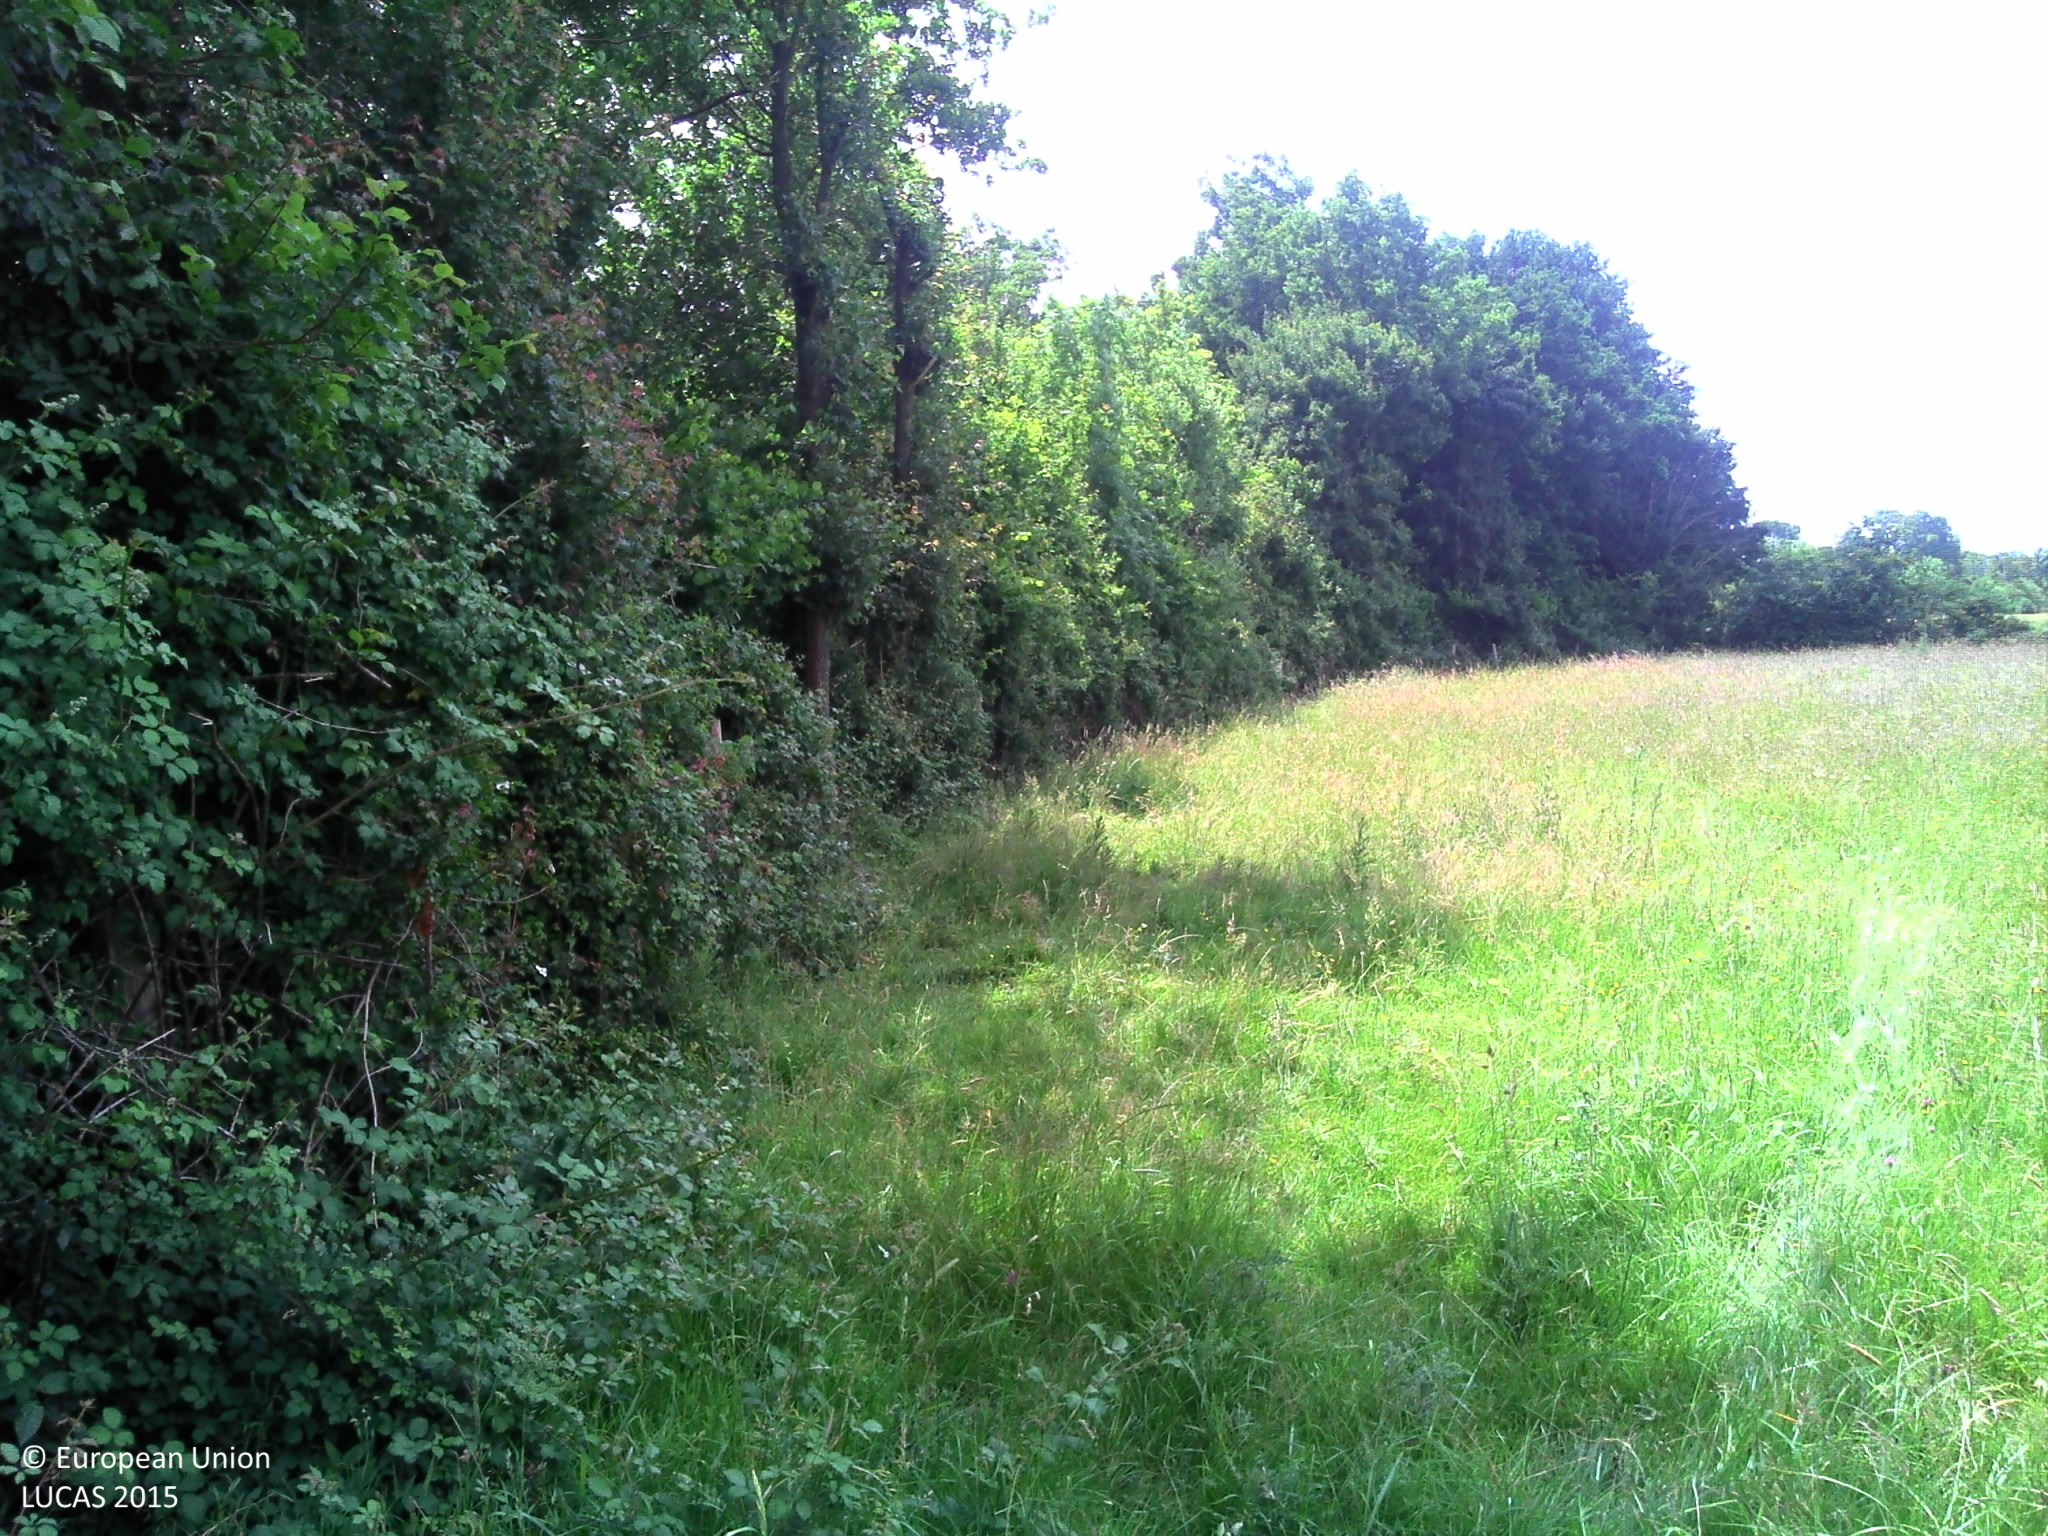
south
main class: Grassland
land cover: Grassland without tree/shrub cover
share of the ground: > 75 %
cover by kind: herbaceous plants 100 %
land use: Agriculture (excluding fallow land and kitchen gardens)
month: June
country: FR
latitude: 48.6092
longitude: 0.0836
